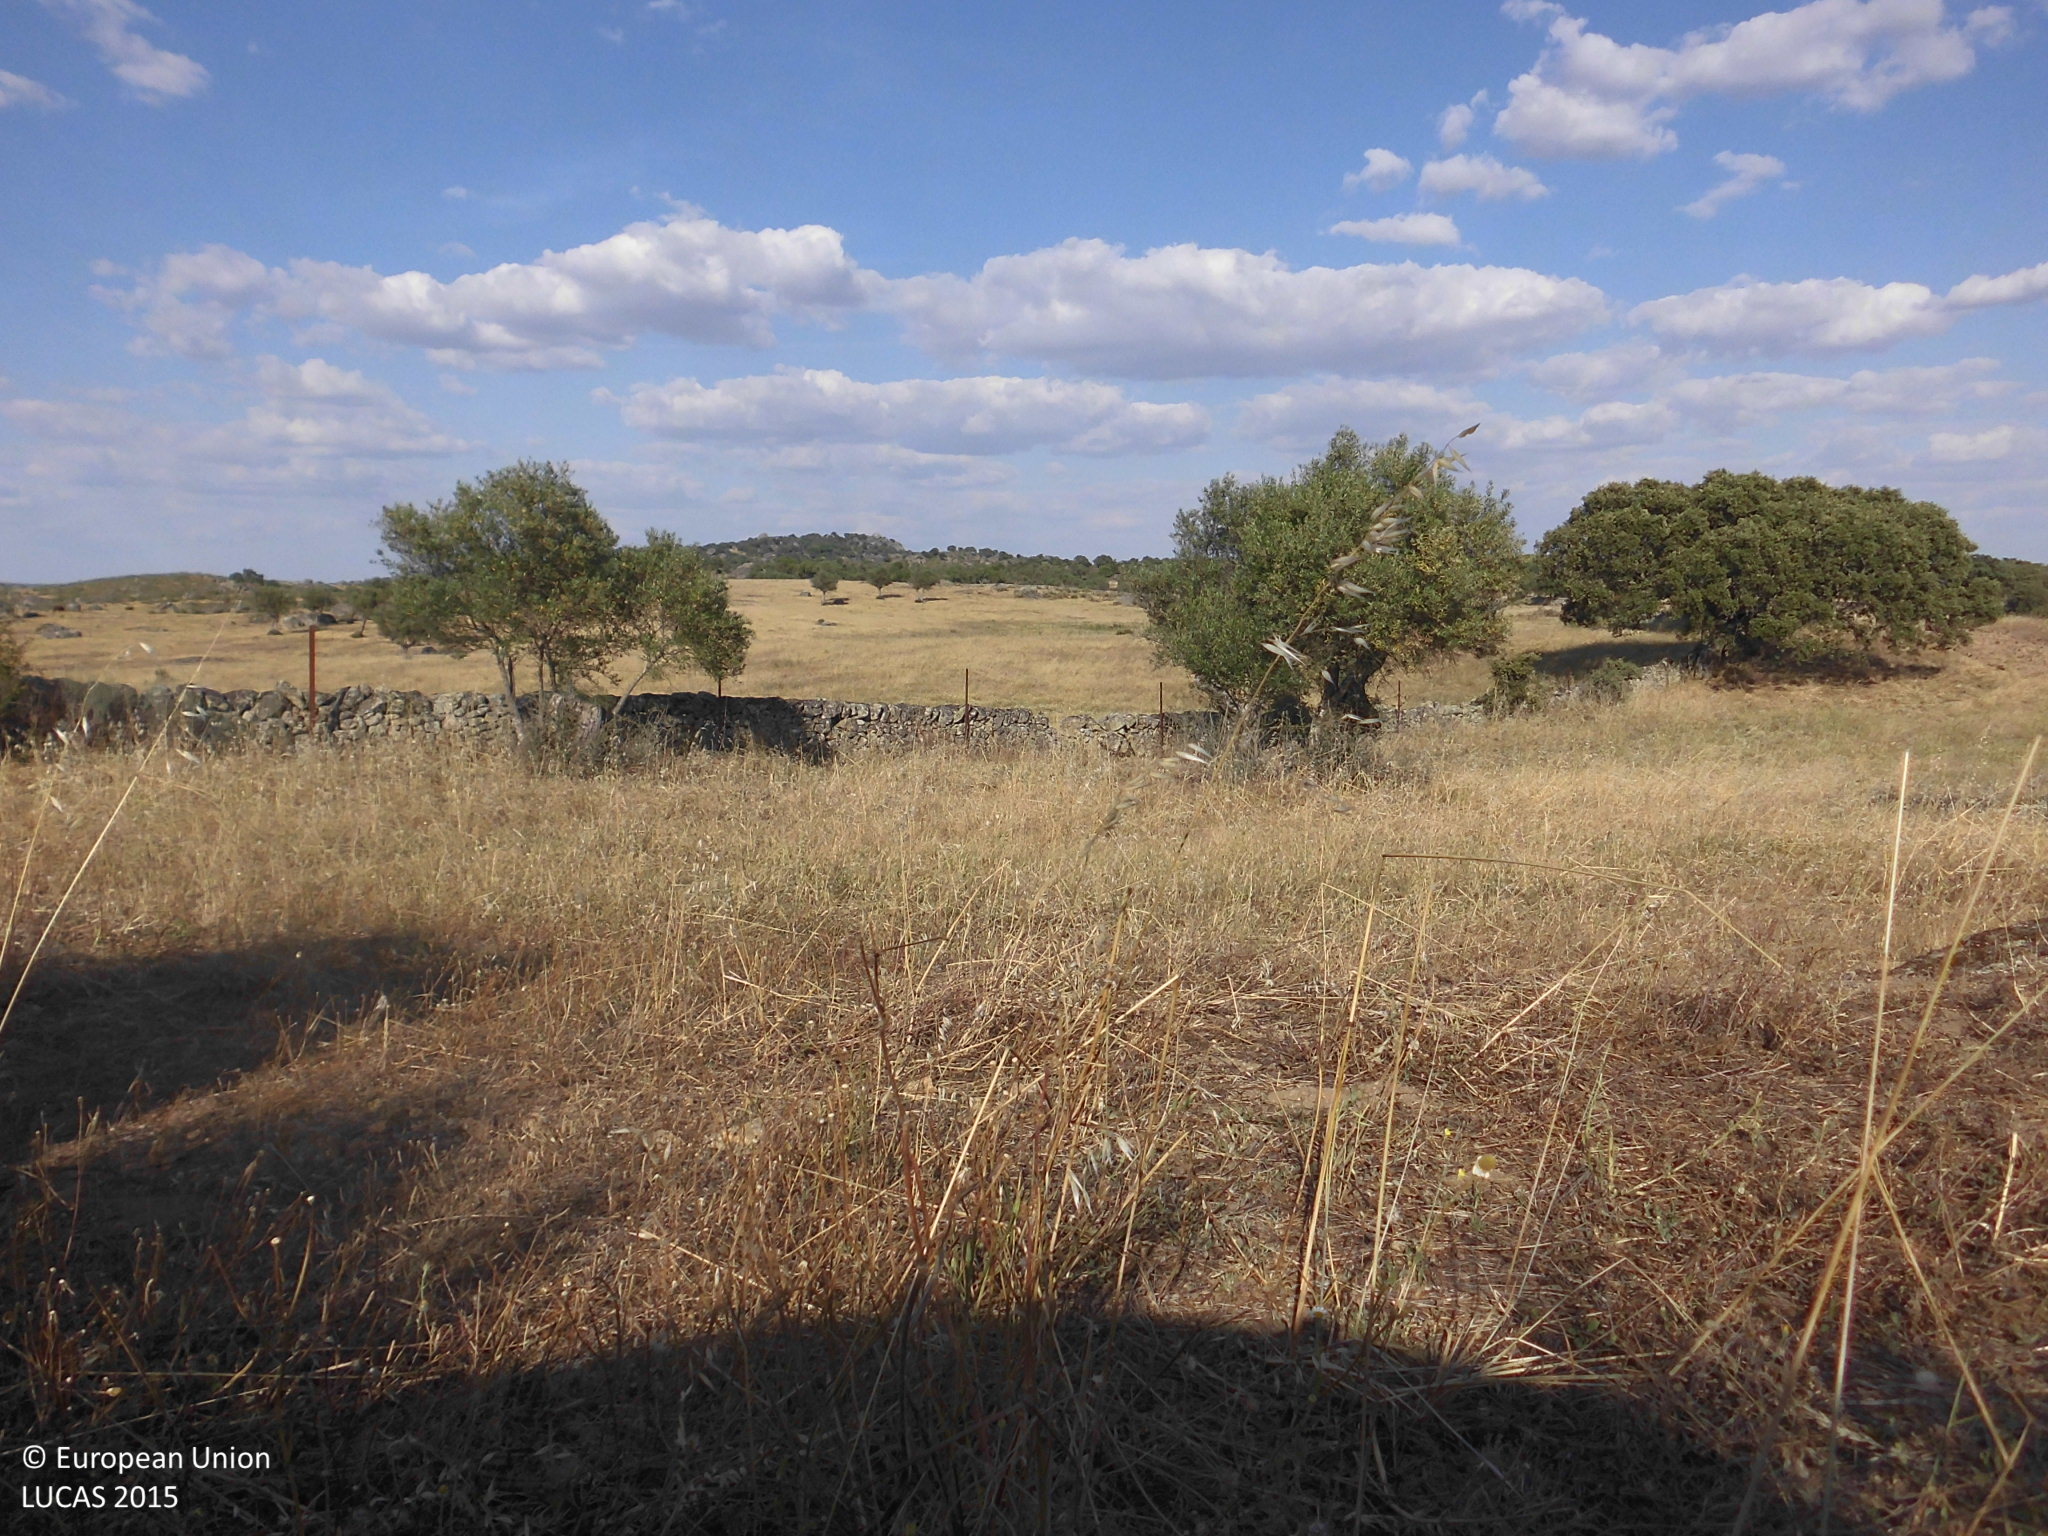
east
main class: Cropland
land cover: Olive groves
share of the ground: > 75 %
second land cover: Shrubland without tree cover
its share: > 75 %
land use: Abandoned areas
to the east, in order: Olive groves; Shrubland without tree cover; Other structural elements; Dry stone walls; Grassland without tree/shrub cover; Rivers and streams; Grassland without tree/shrub cover
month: May
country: ES
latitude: 39.5858
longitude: -6.6676
